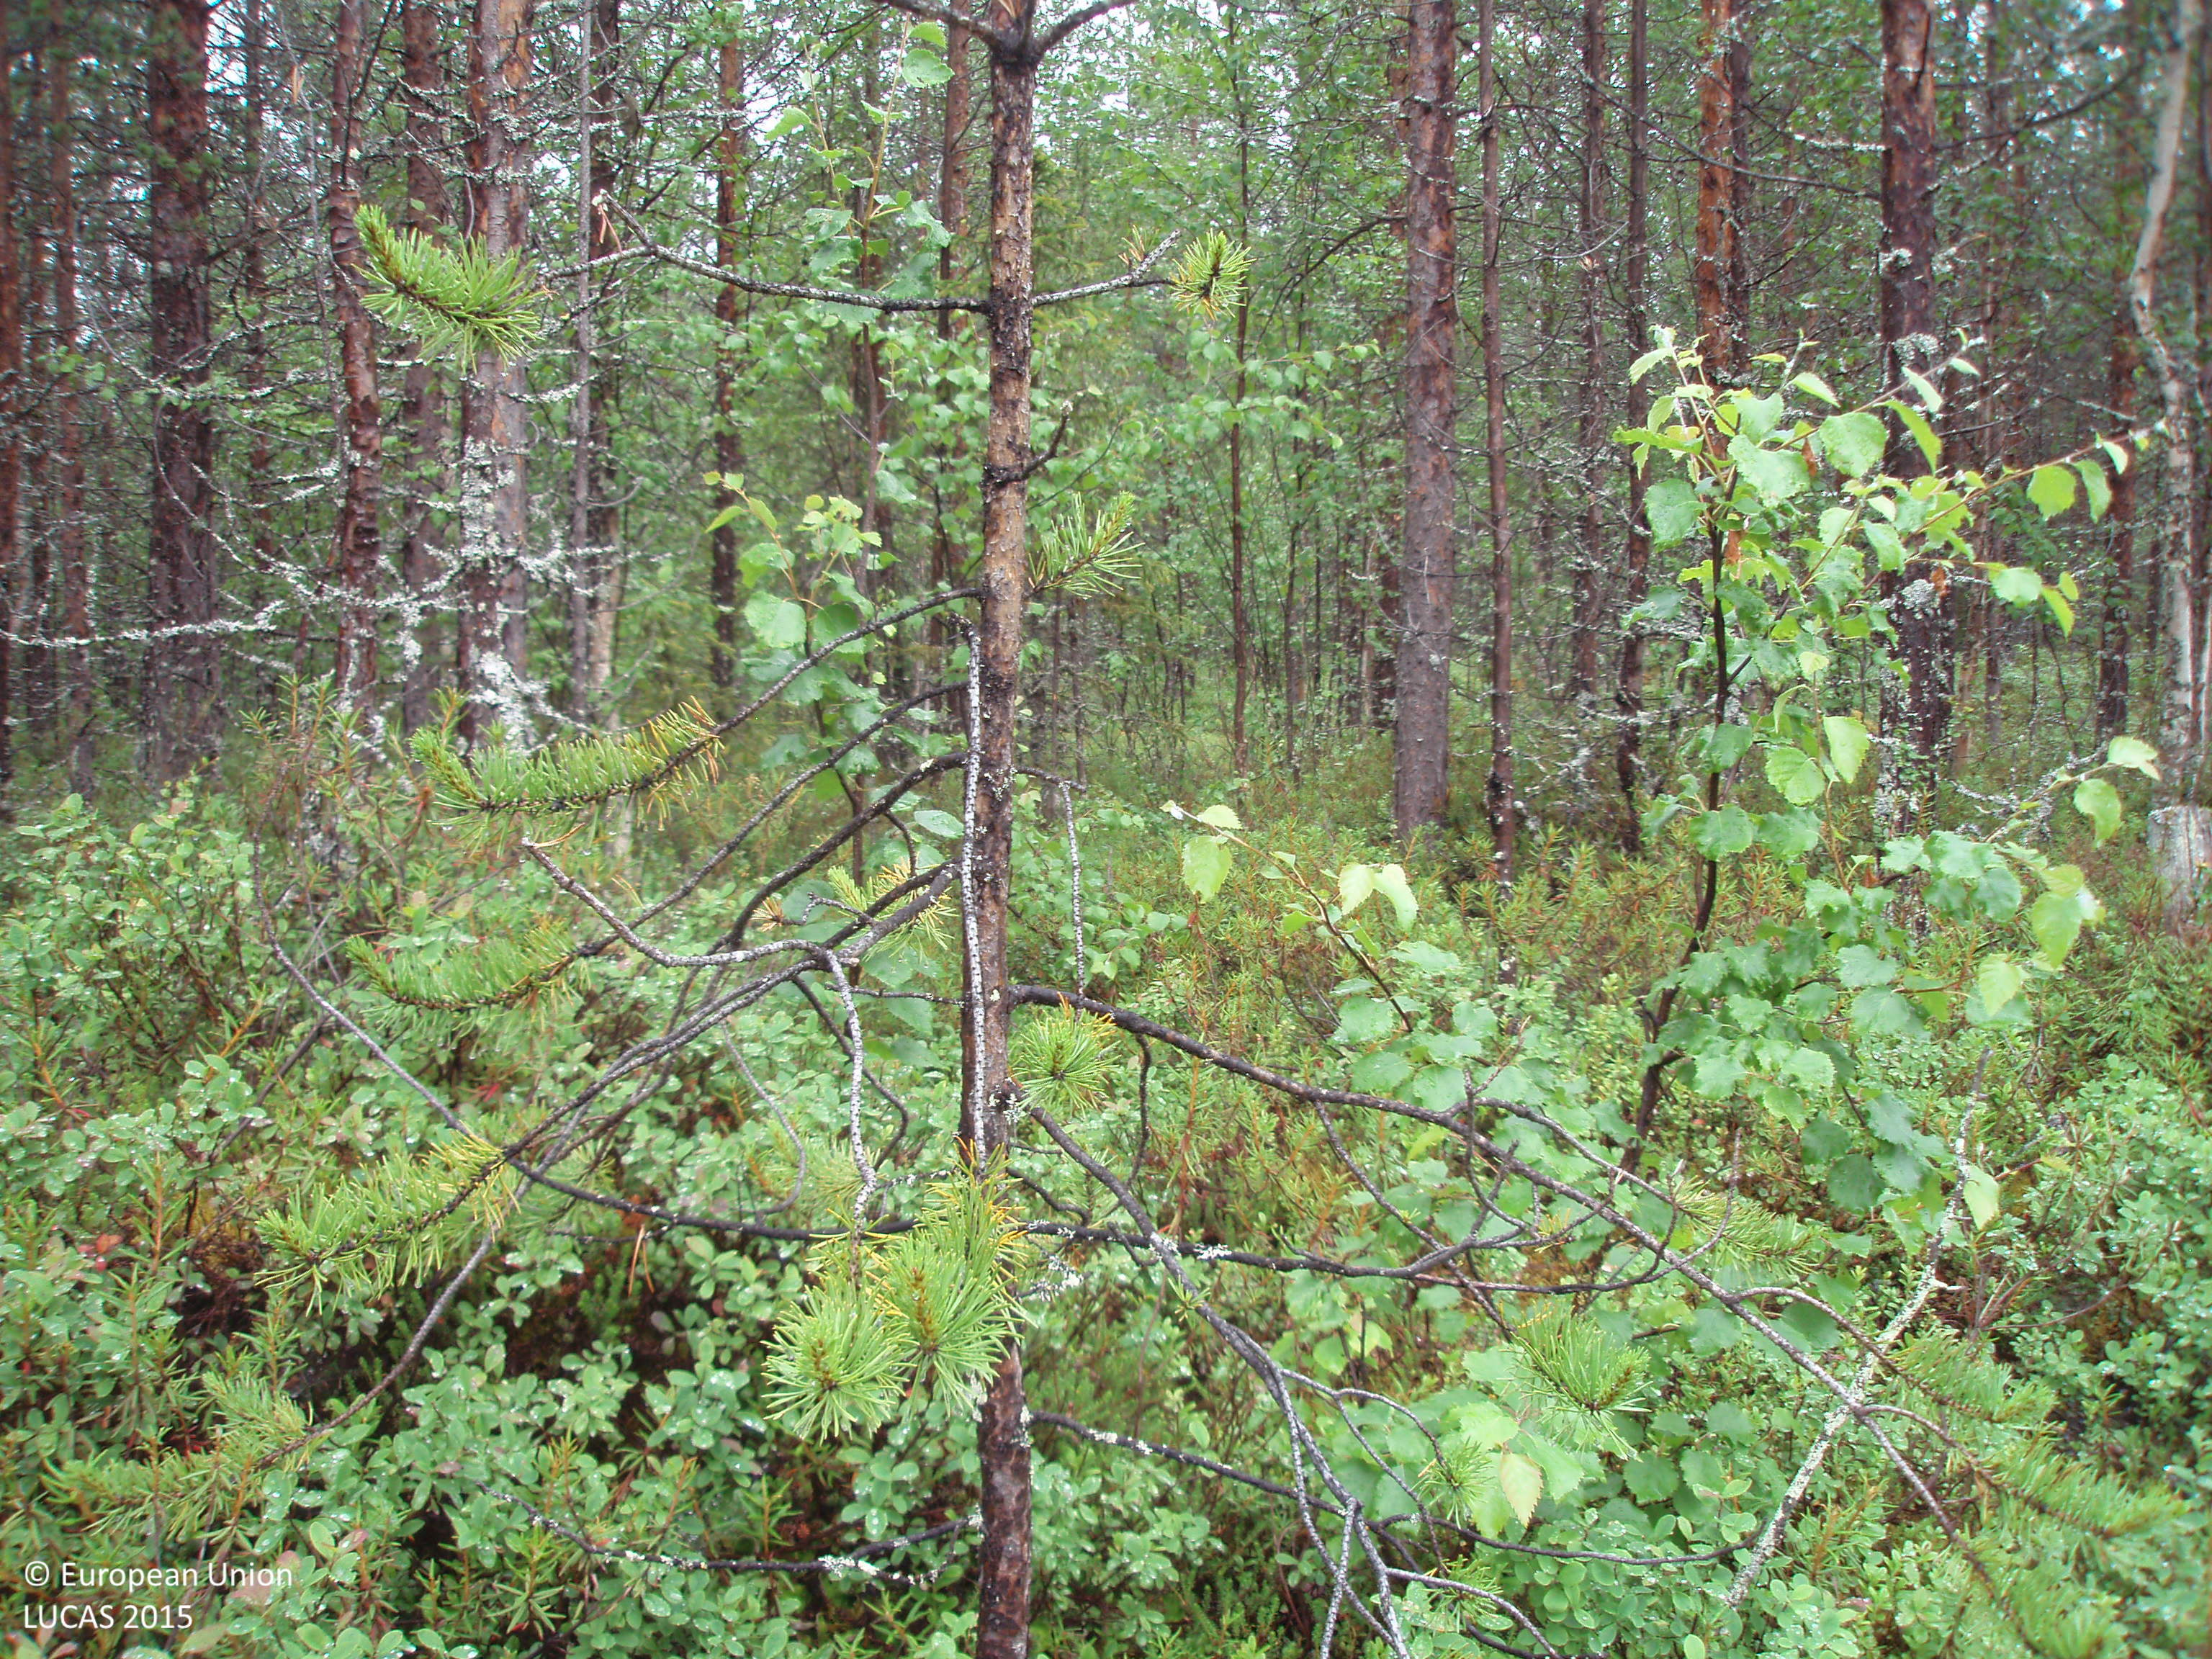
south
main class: Woodland
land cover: Pine dominated coniferous woodland
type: boreal forest
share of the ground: 50 - 75 %
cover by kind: shrubs 50 %, coniferous forest trees 45 %, broadleaved forest trees 5 %
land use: Forestry
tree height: > 5 m
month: July
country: FI
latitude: 66.6405
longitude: 28.0050
